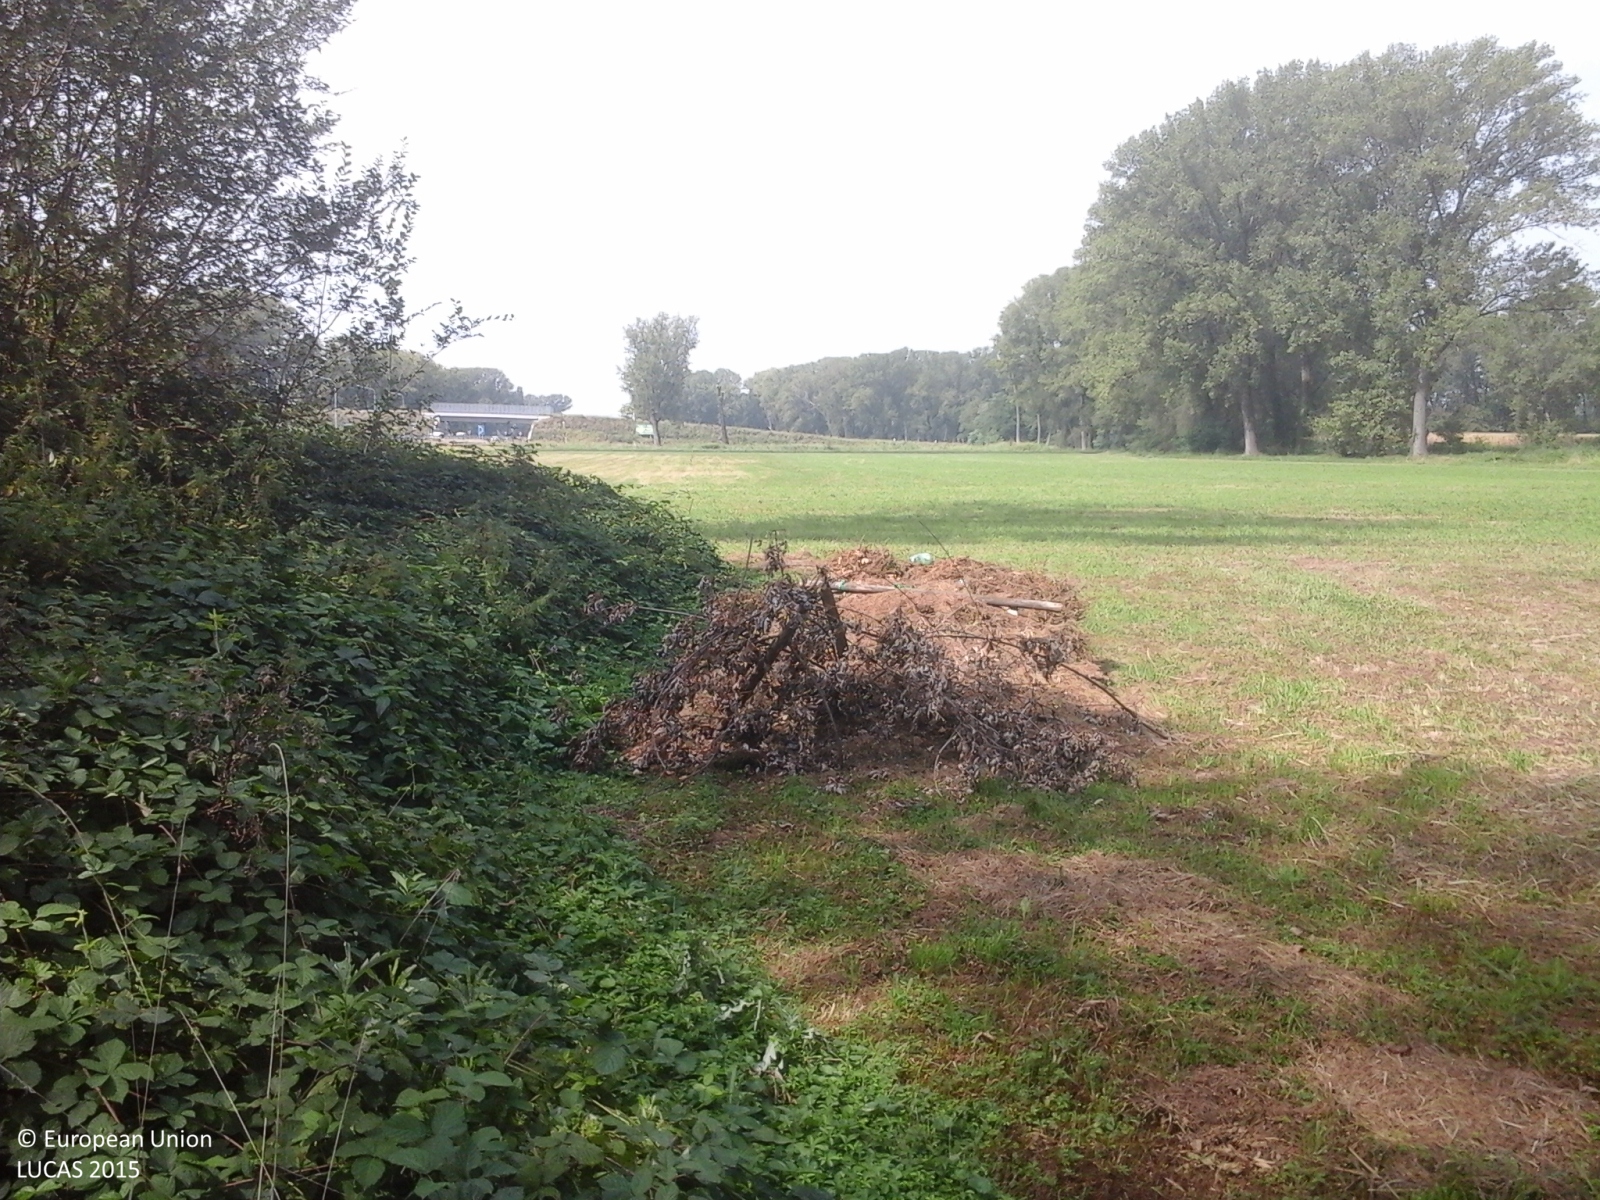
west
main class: Grassland
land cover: Spontaneously vegetated surfaces
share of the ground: > 75 %
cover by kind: herbaceous plants 95 %, shrubs 5 %
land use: Semi-natural and natural areas not in use
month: September
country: IT
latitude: 45.4845
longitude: 9.3742
